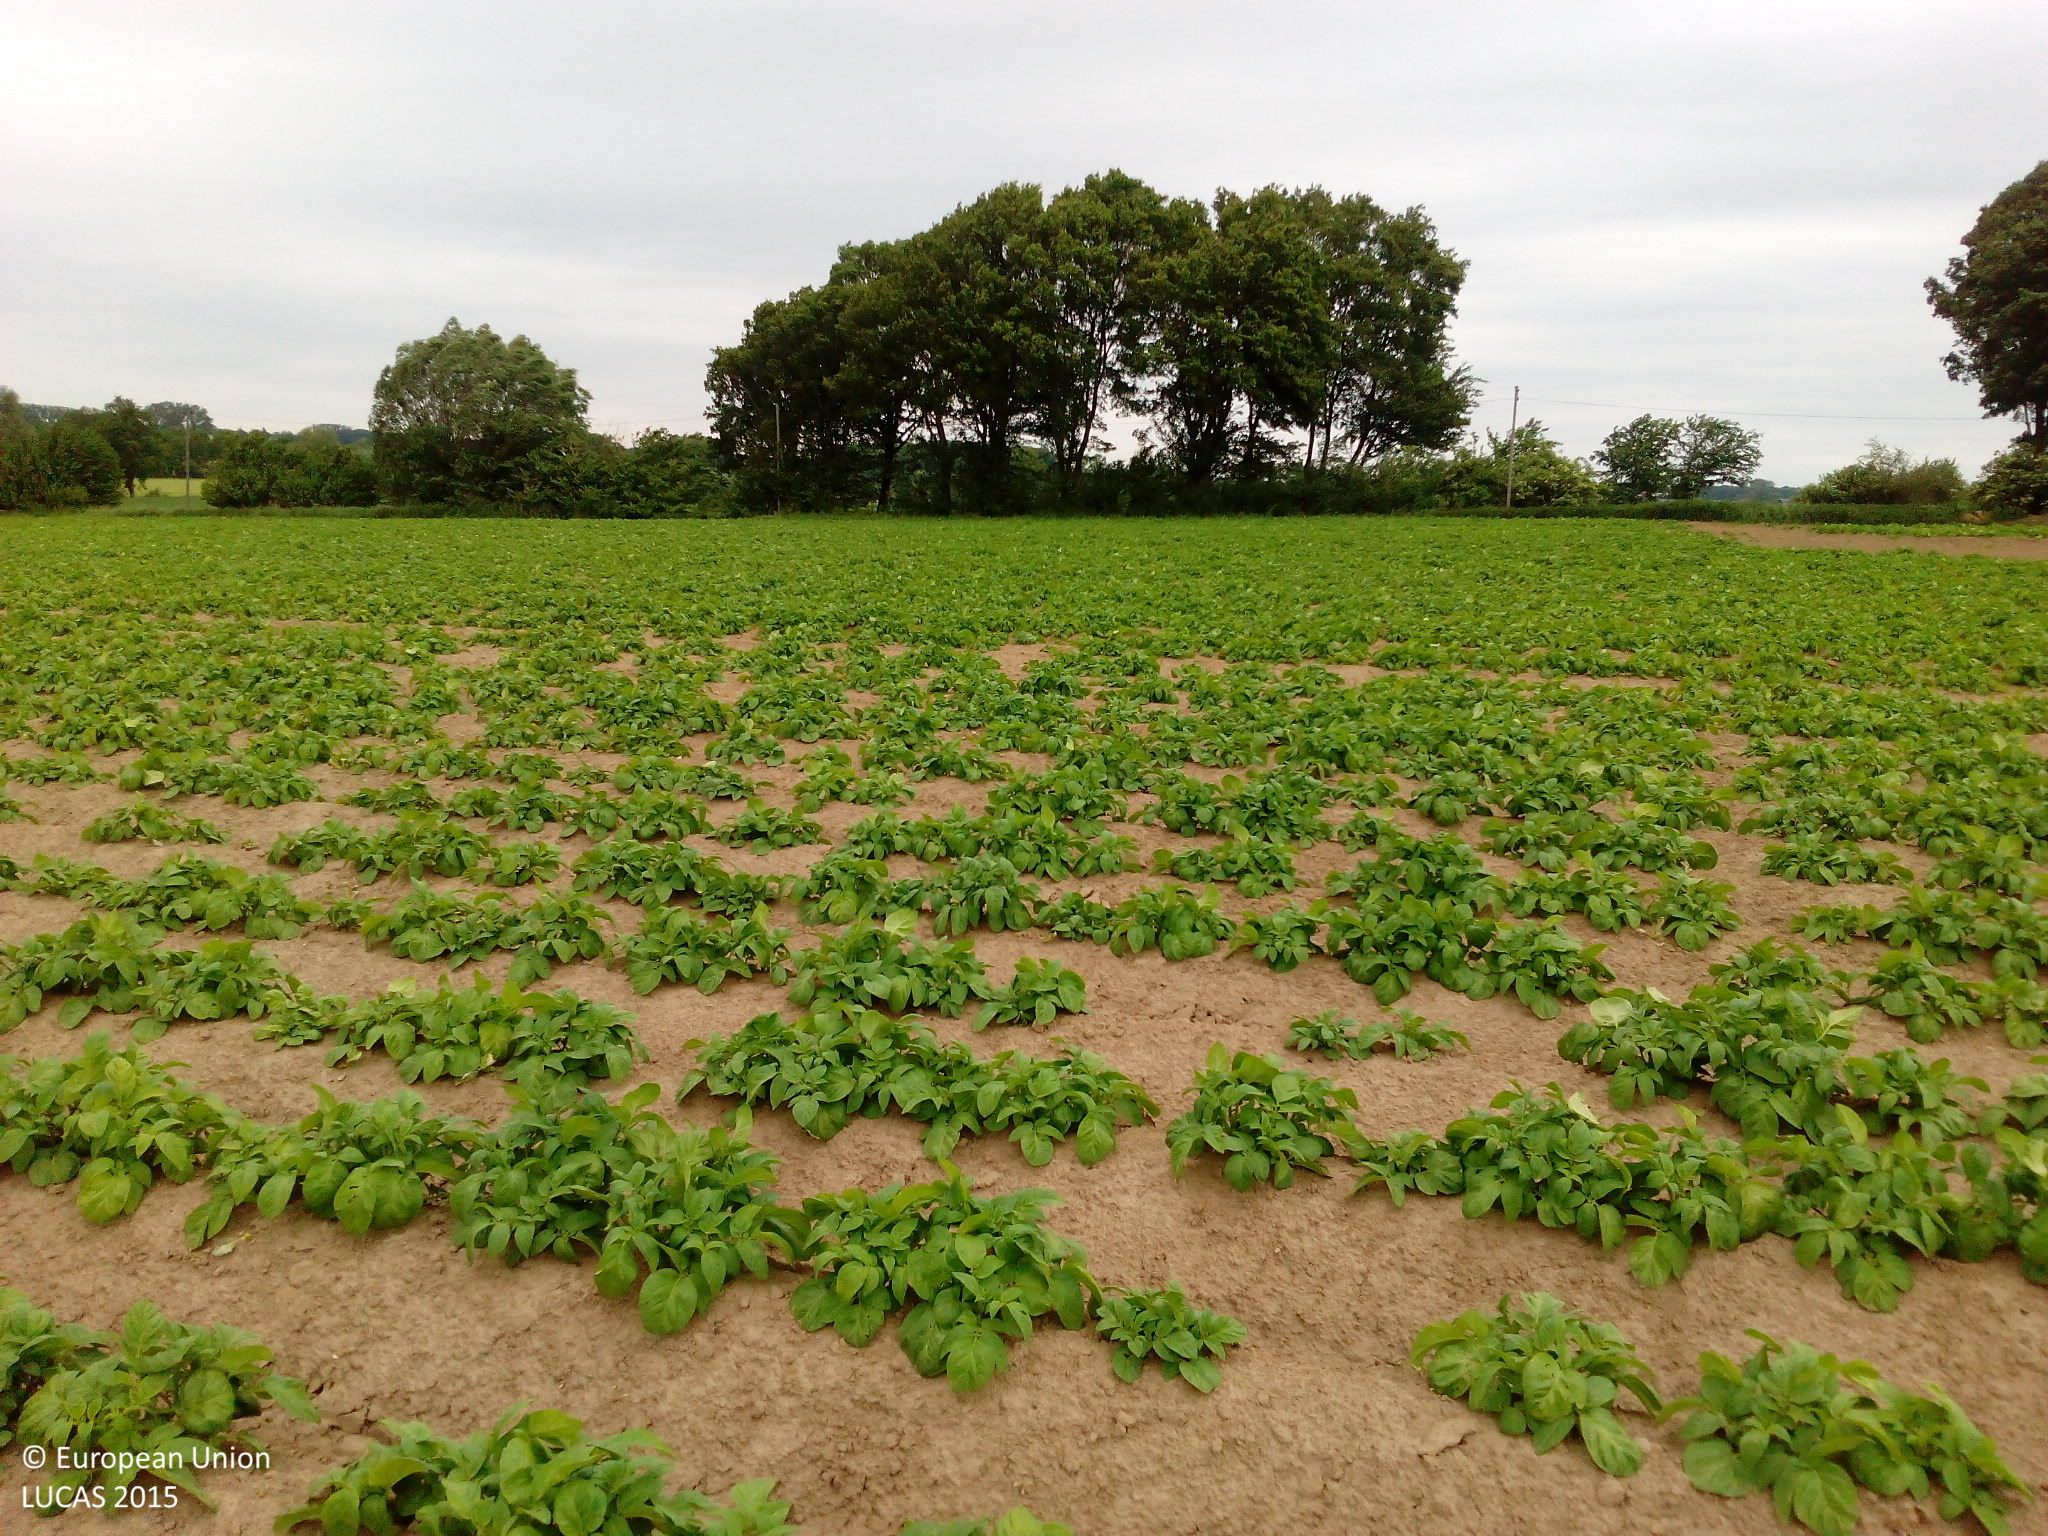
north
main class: Cropland
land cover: Potatoes
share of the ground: 25 - 50 %
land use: Agriculture (excluding fallow land and kitchen gardens)
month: June
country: DE
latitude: 51.5689
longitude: 7.9661
